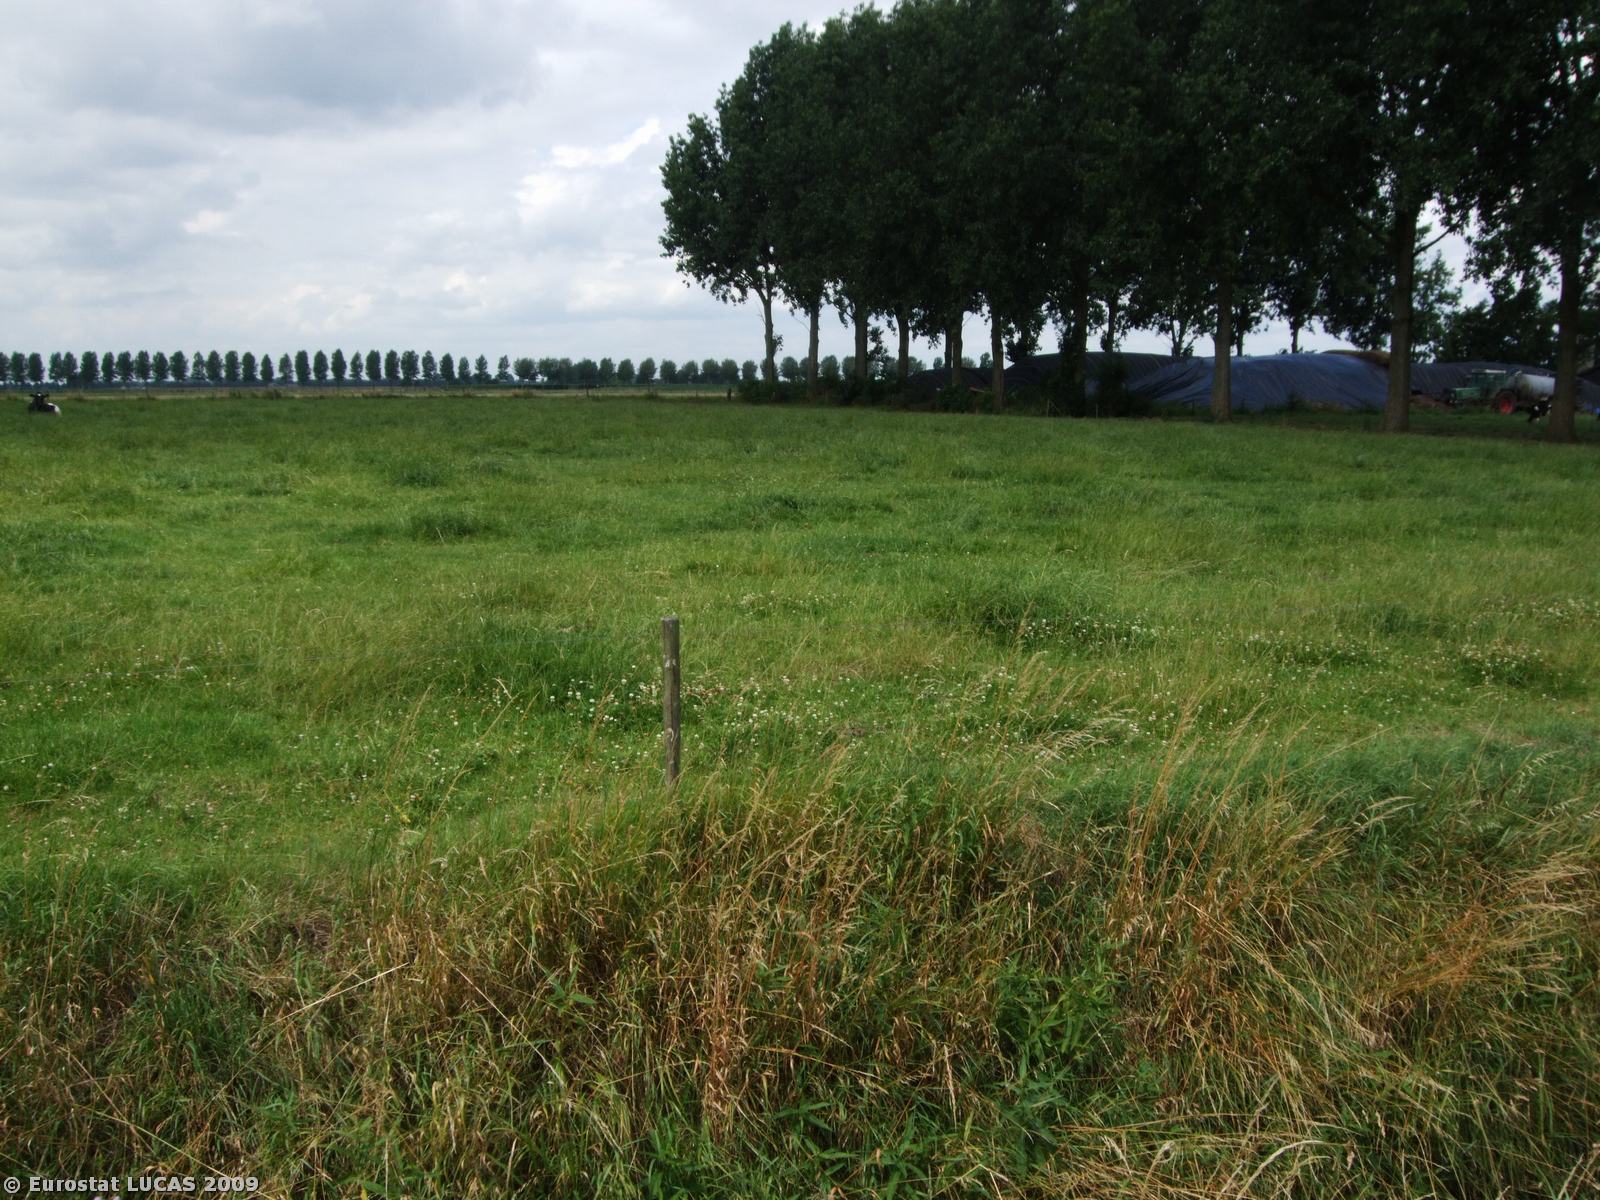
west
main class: Grassland
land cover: Grassland without tree/shrub cover
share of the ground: > 75 %
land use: Agriculture (excluding fallow land and kitchen gardens)
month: July
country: NL
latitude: 51.9267
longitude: 5.3591
